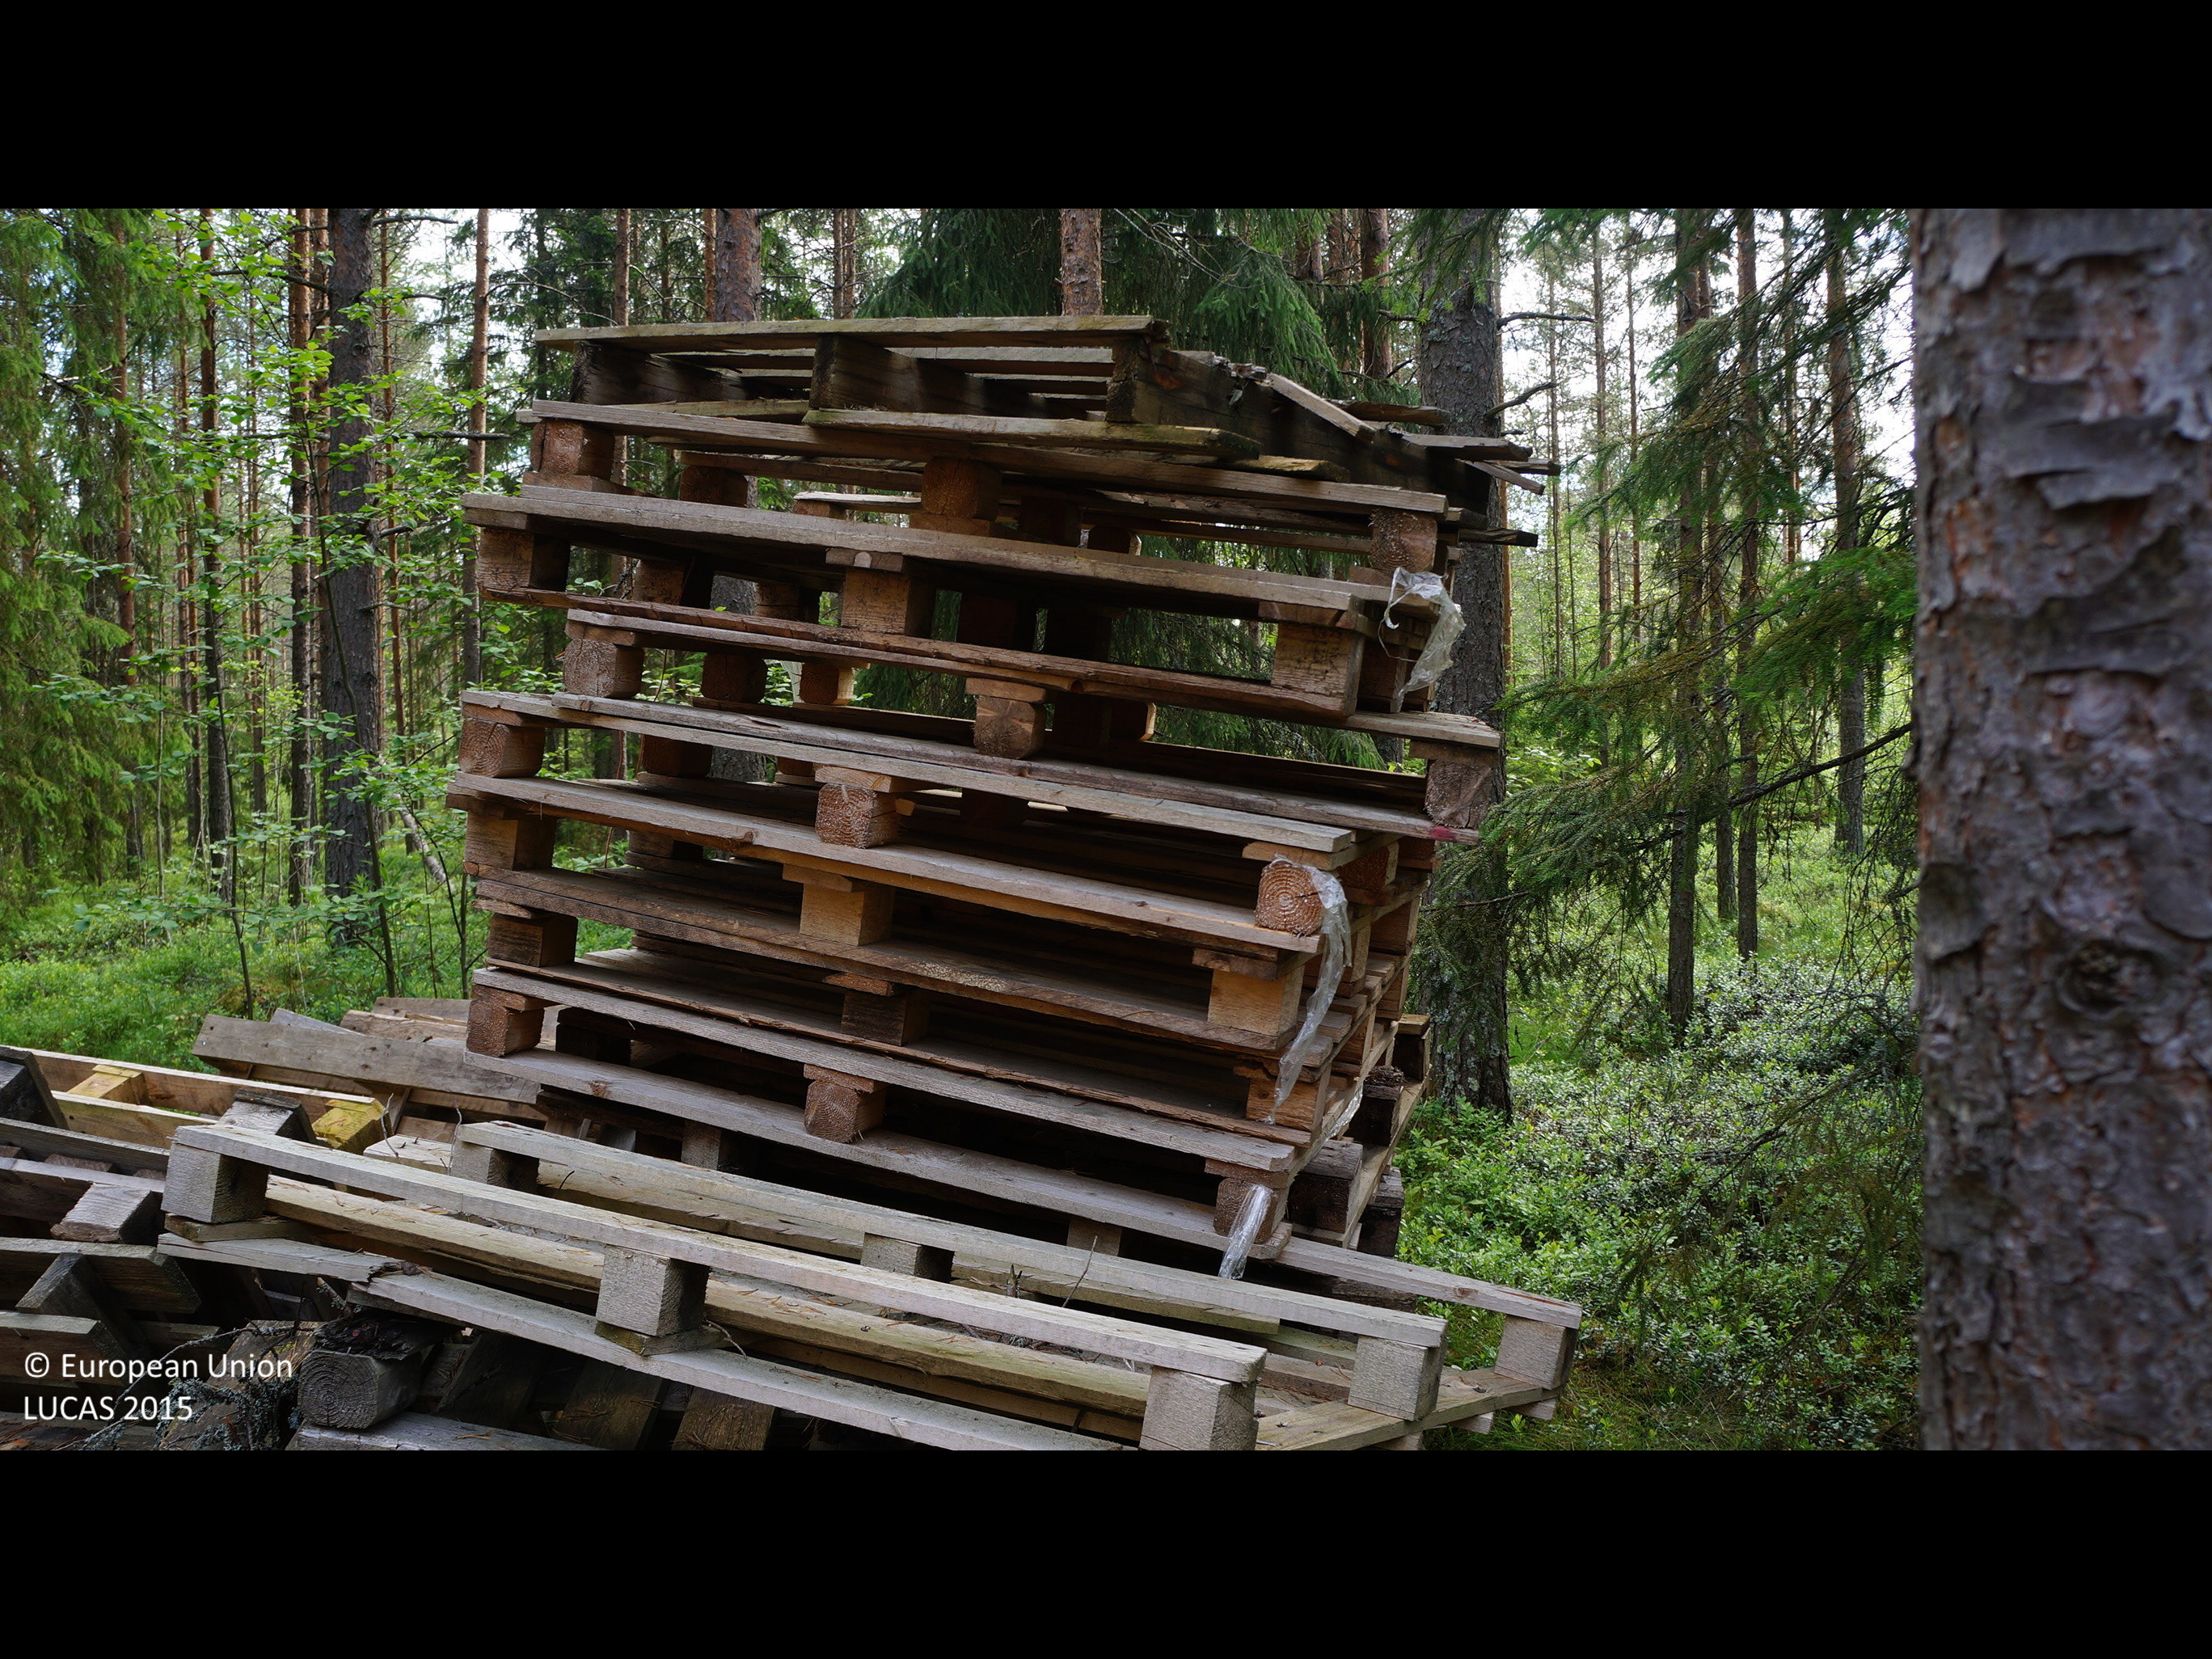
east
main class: Woodland
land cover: Pine dominated coniferous woodland
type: boreal forest
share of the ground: 50 - 75 %
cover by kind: coniferous forest trees 60 %, shrubs 30 %, herbaceous plants 5 %, lichens and mosses 5 %
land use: Forestry
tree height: > 5 m
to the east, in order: Pine dominated coniferous woodland; Ditches and canals; Pine dominated coniferous woodland; Broadleaved woodland; Electric lines; Broadleaved woodland; Pine dominated coniferous woodland; Shruby margins; Tracks; Shruby margins; Paved roads, cycling and walking lanes; Grassland without tree/shrub cover; Electric lines; Other bare soil
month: July
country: FI
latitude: 64.3435
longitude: 24.4145
